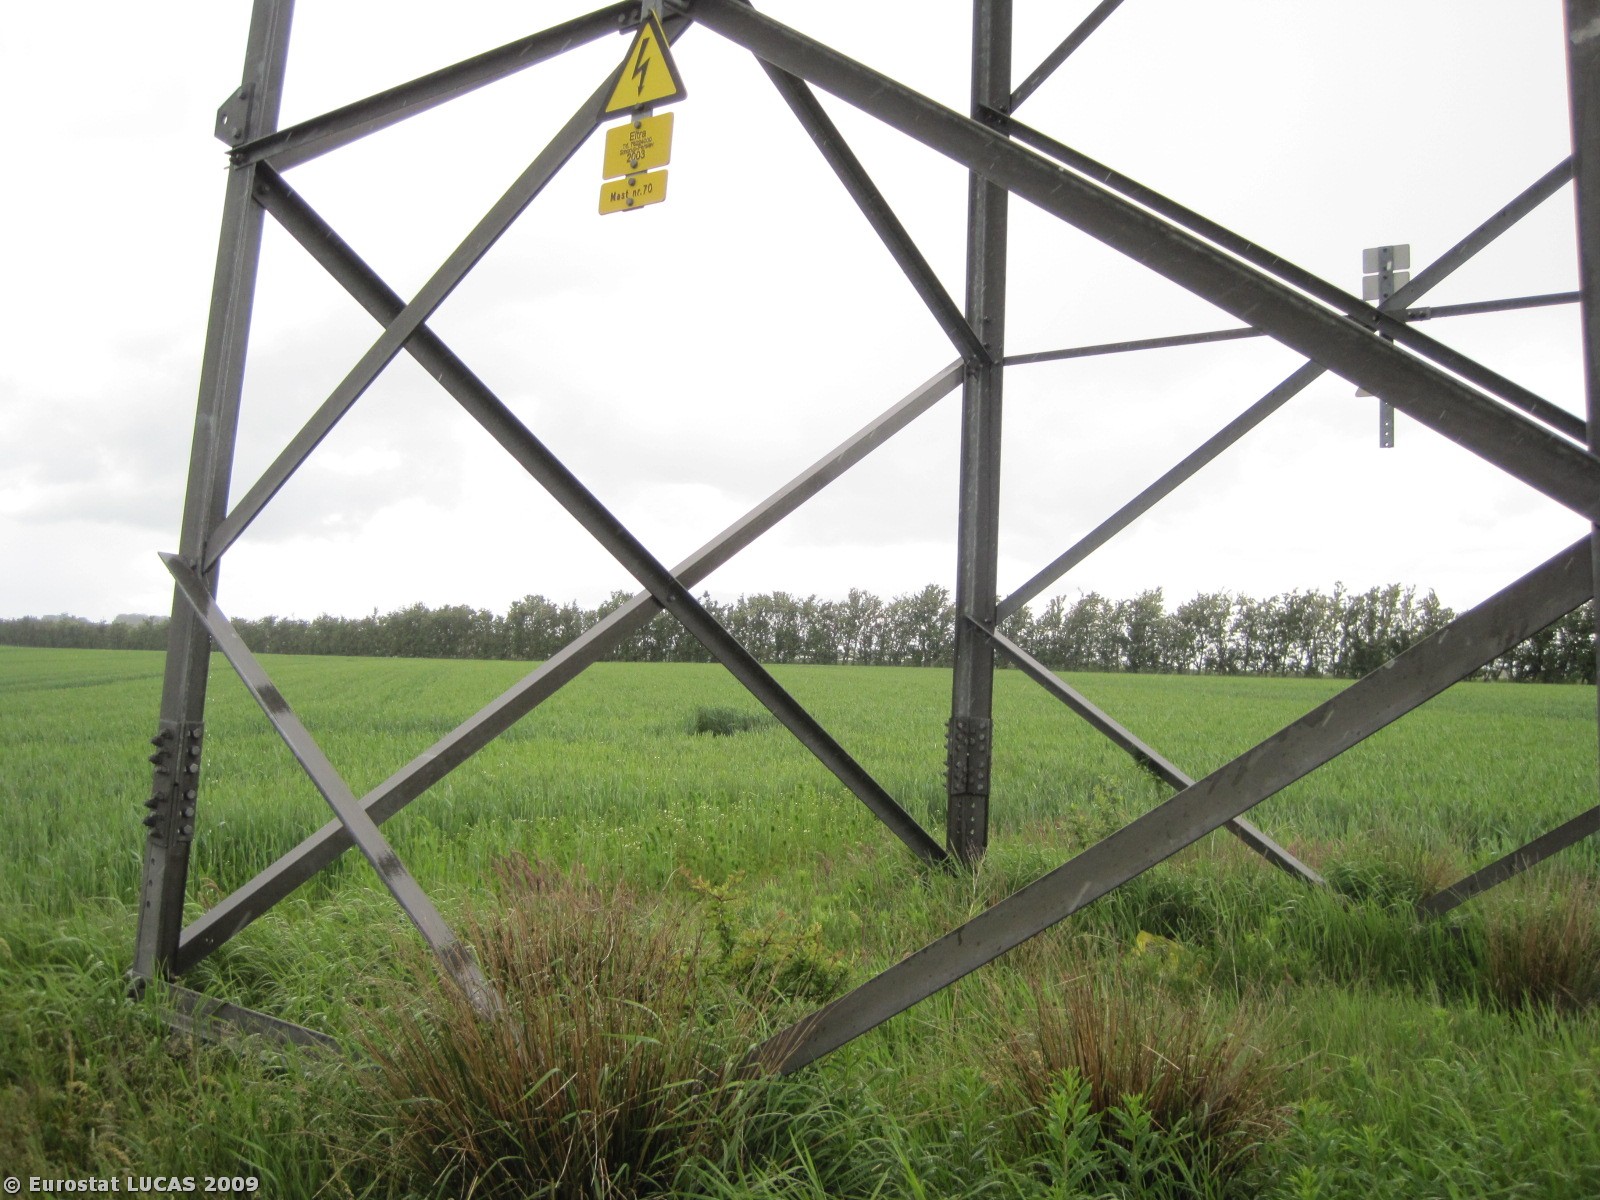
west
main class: Cropland
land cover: Common wheat
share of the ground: > 75 %
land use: Agriculture (excluding fallow land and kitchen gardens)
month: June
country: DK
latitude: 56.9426
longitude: 9.7866
